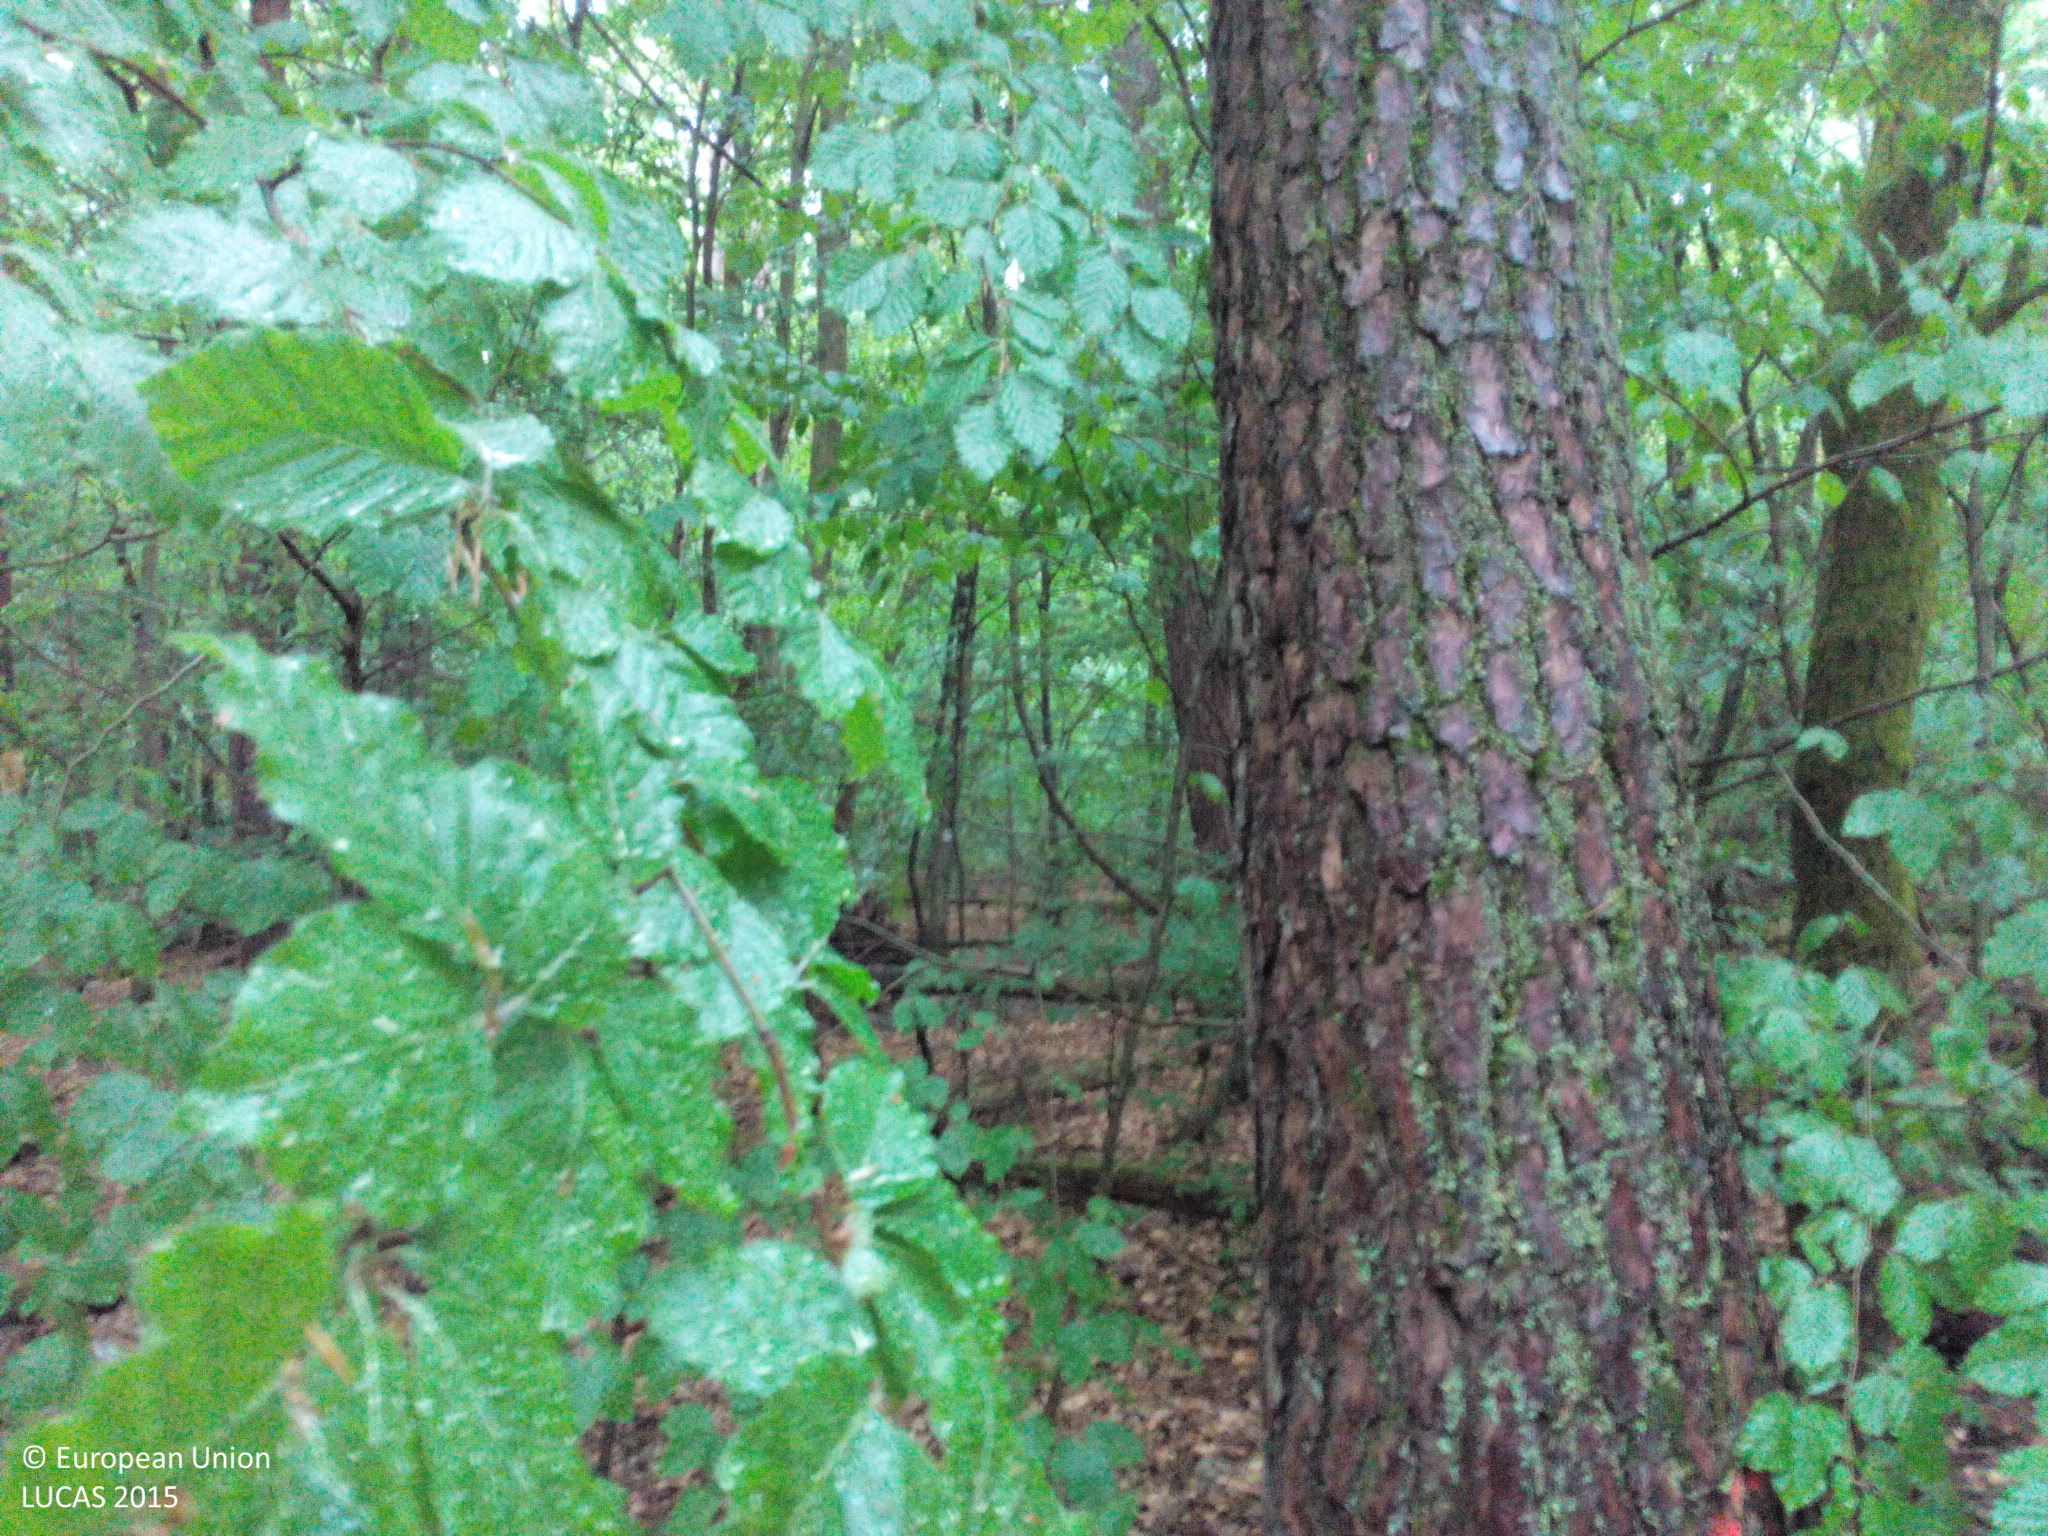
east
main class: Woodland
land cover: Broadleaved woodland
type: beech forest
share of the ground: > 75 %
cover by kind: broadleaved forest trees 70 %, coniferous forest trees 10 %, shrubs 10 %, unconsolidated bare surface 10 %
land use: Forestry
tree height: > 5 m
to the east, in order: Broadleaved woodland; Pine dominated mixed woodland; Broadleaved woodland; Ditches and canals; Broadleaved woodland; Ditches and canals; Broadleaved woodland
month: May
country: DE
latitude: 49.0359
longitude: 8.1540
